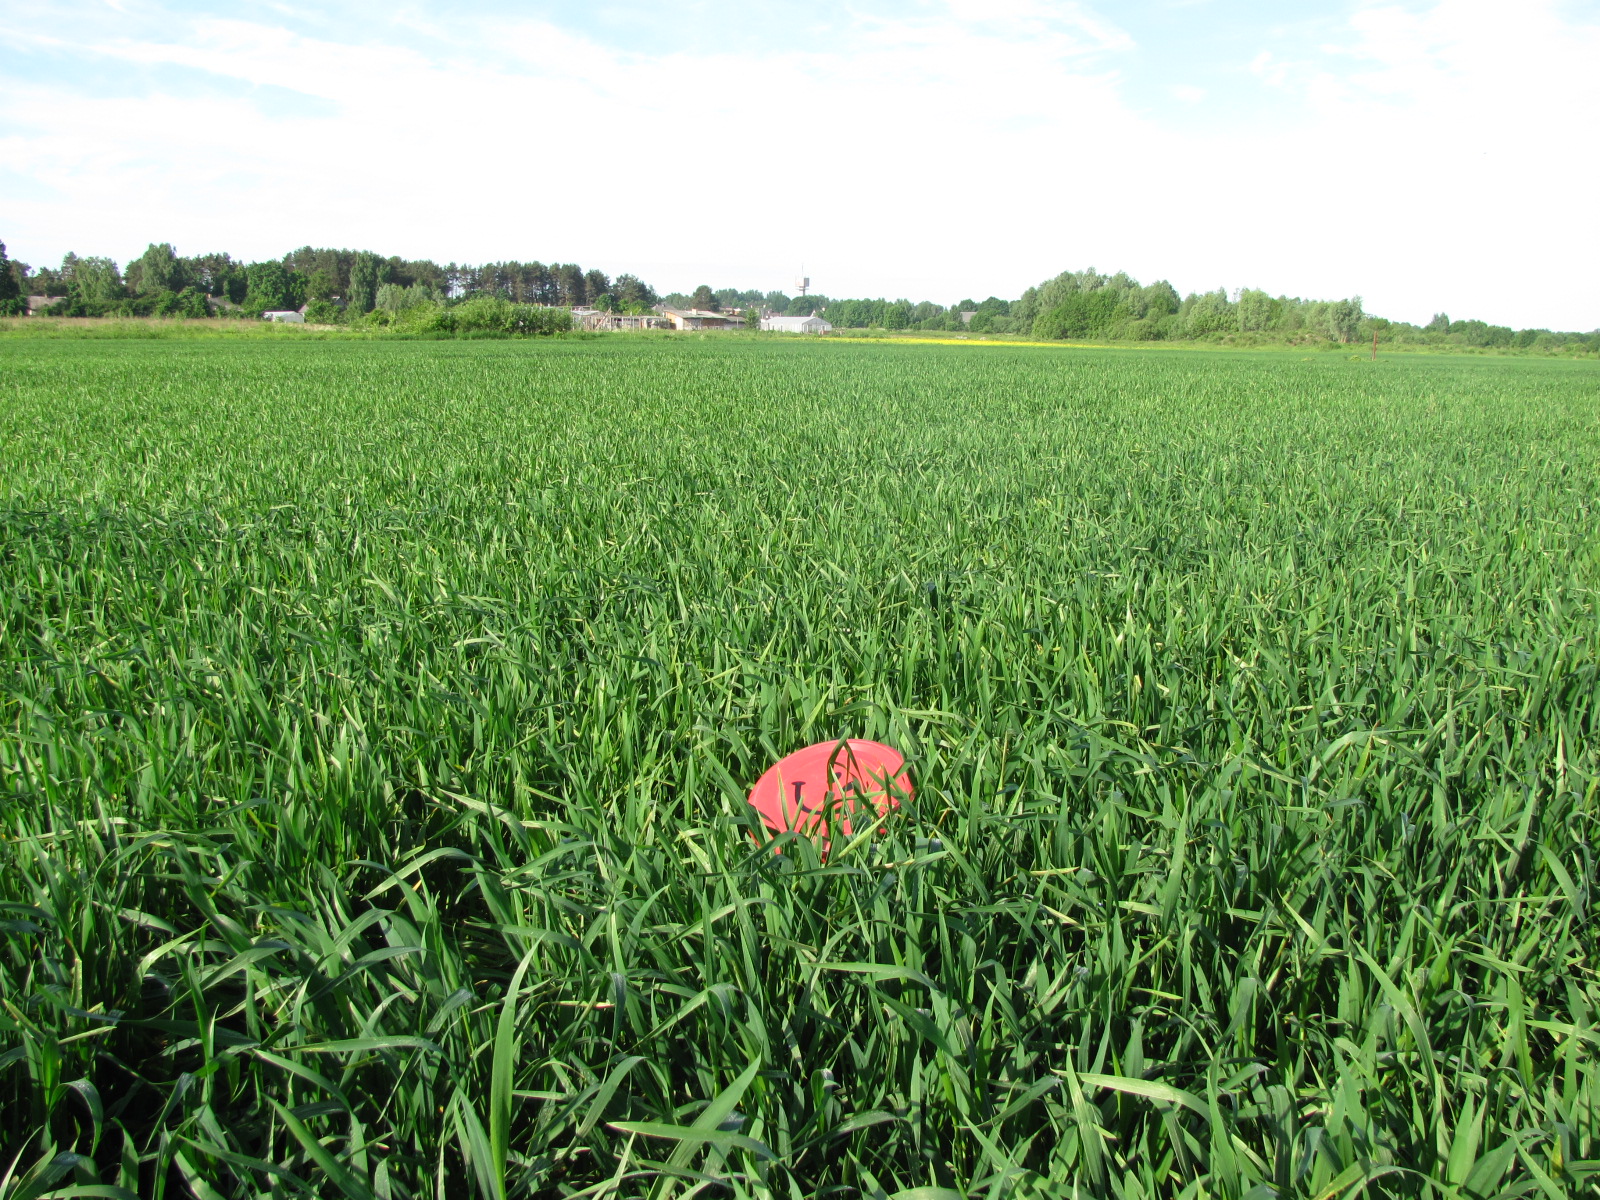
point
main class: Cropland
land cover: Common wheat
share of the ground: > 75 %
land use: Agriculture (excluding fallow land and kitchen gardens)
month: June
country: LV
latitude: 56.8305
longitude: 24.2651
